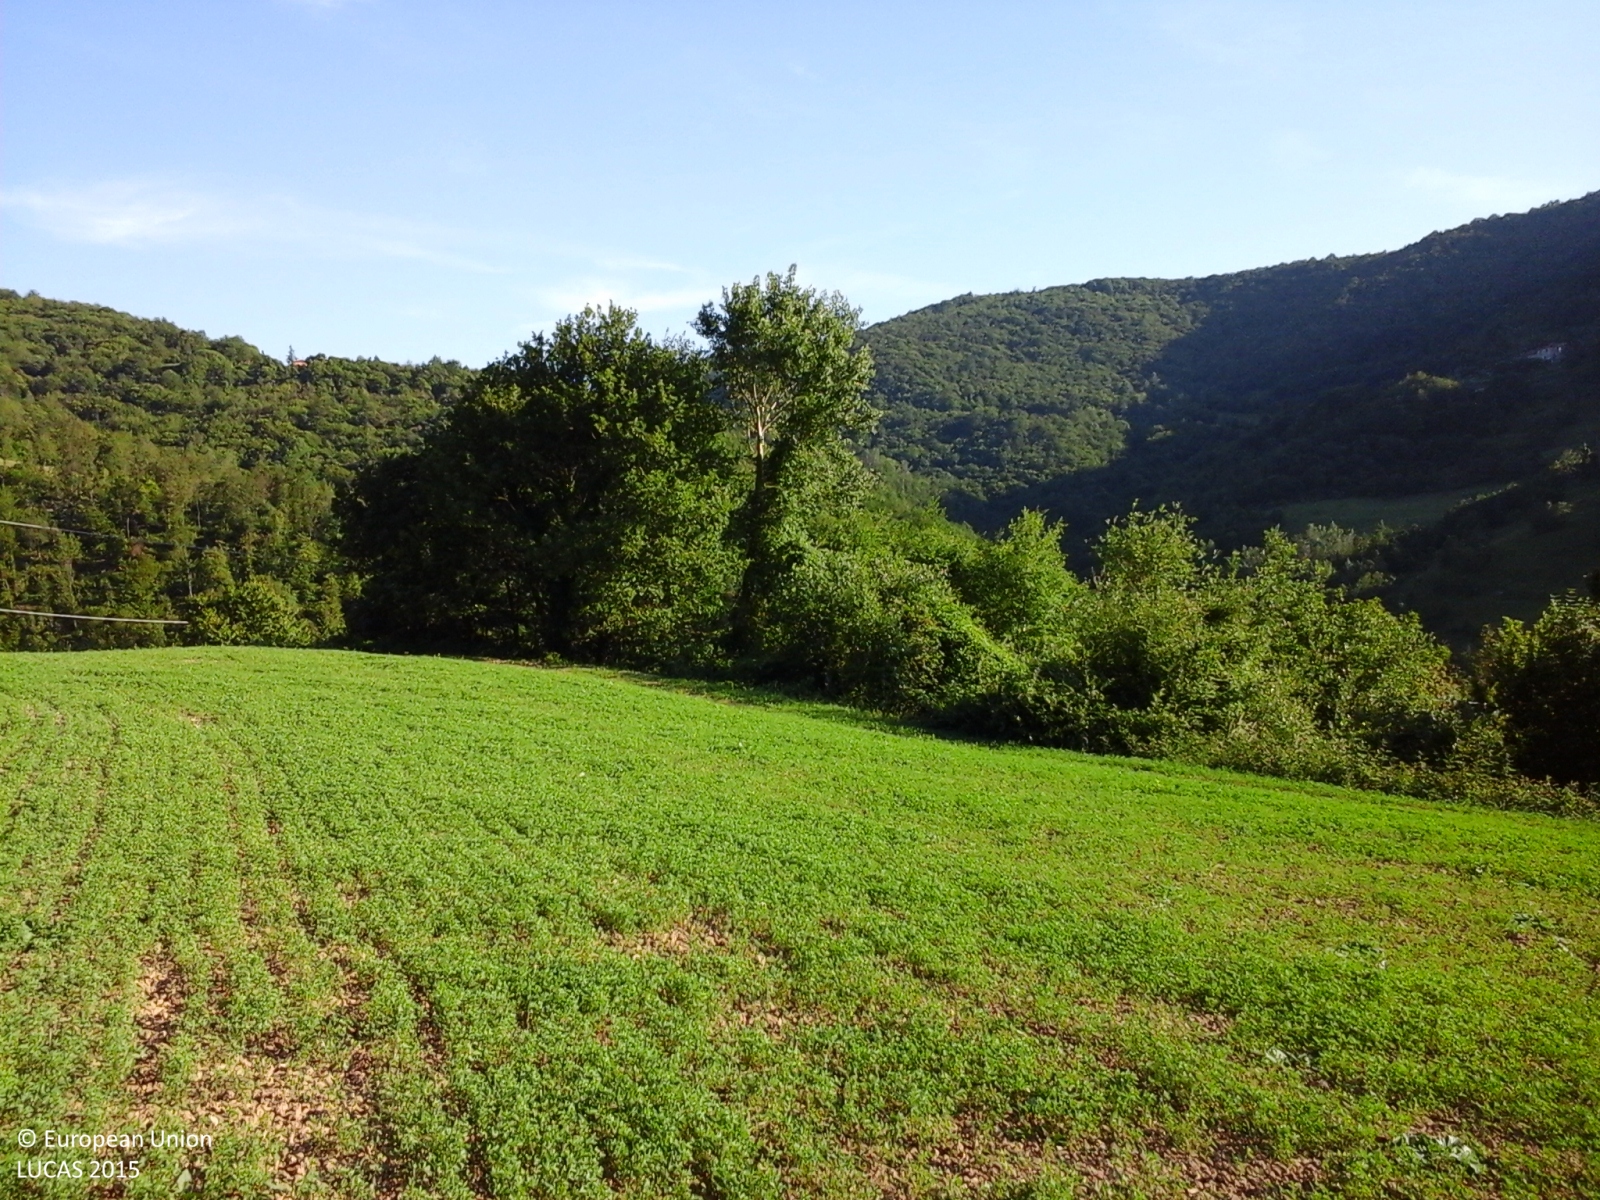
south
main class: Cropland
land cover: Lucerne
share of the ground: > 75 %
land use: Agriculture (excluding fallow land and kitchen gardens)
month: June
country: IT
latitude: 44.5523
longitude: 8.2539
